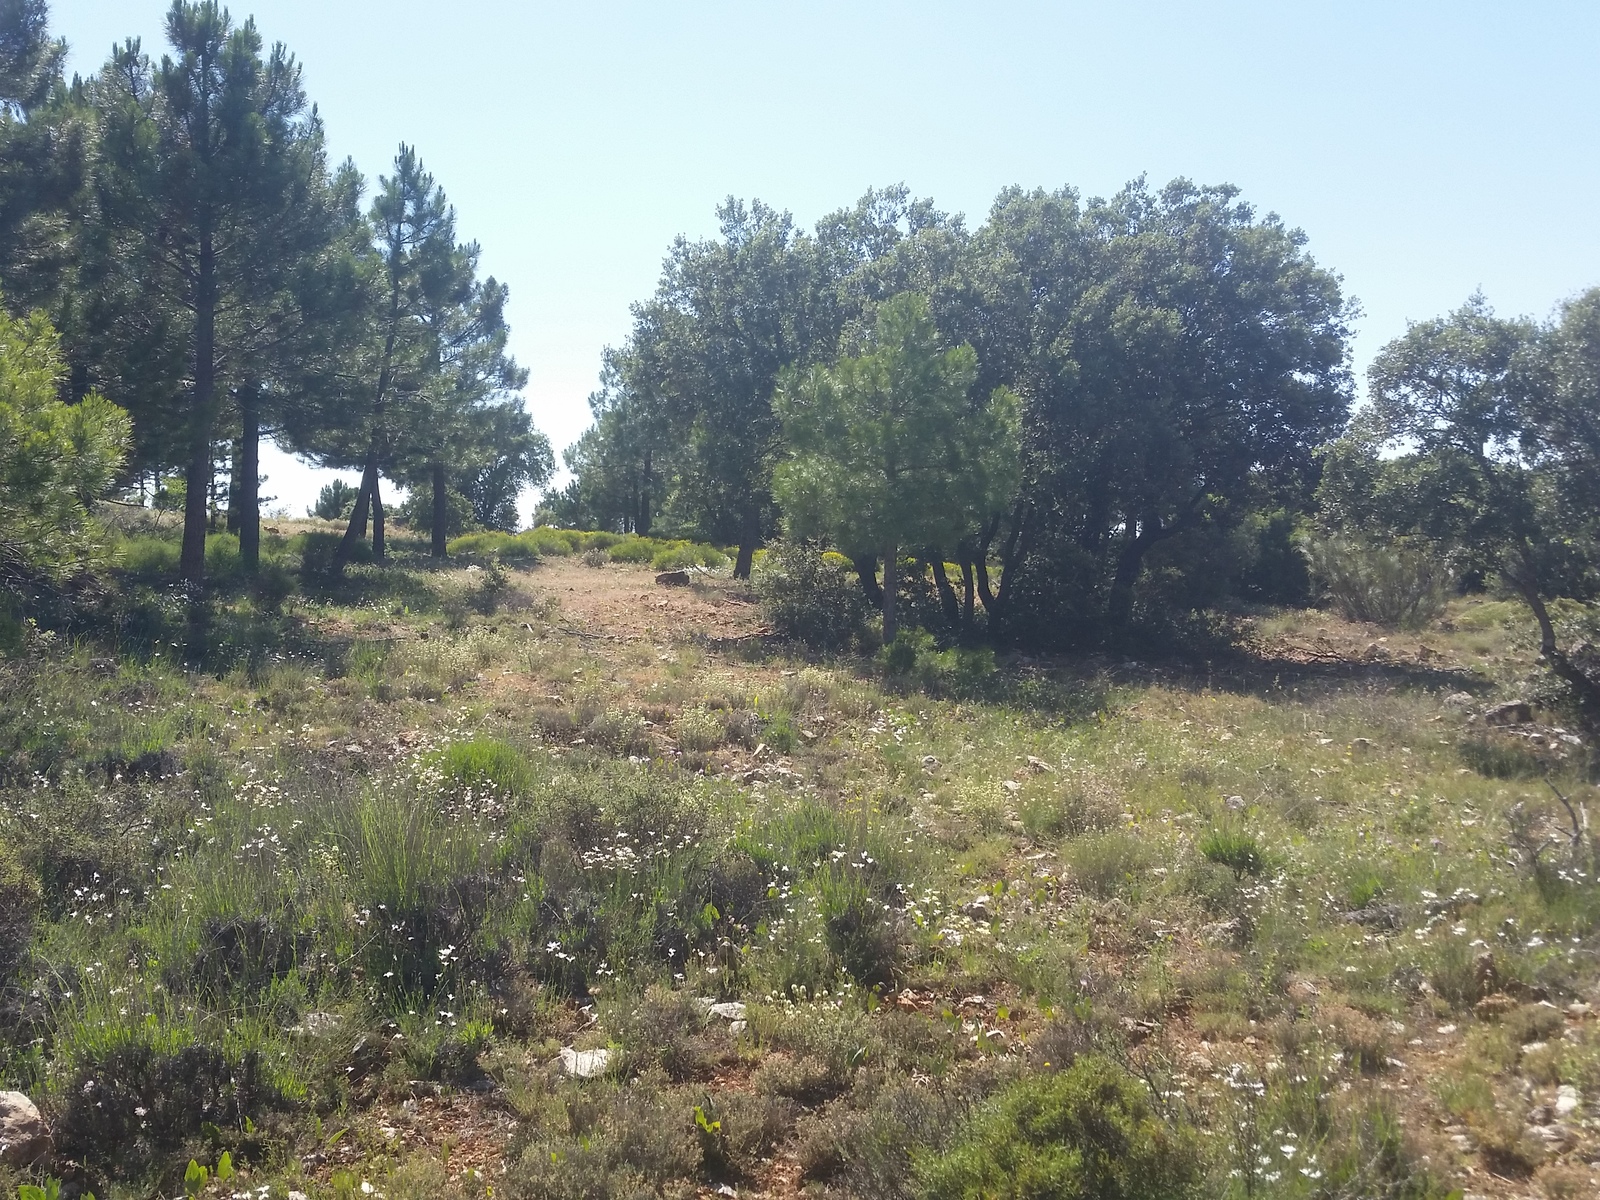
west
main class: Woodland
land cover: Pine dominated mixed woodland
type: coniferous forest of the mediterranean region
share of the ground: > 75 %
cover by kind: shrubs 30 %, coniferous forest trees 25 %, broadleaved forest trees 25 %, consolidated bare surface 15 %, herbaceous plants 5 %
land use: Forestry
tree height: > 5 m
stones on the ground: 10 - 25 %
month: June
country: ES
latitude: 38.5771
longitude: -2.5698
